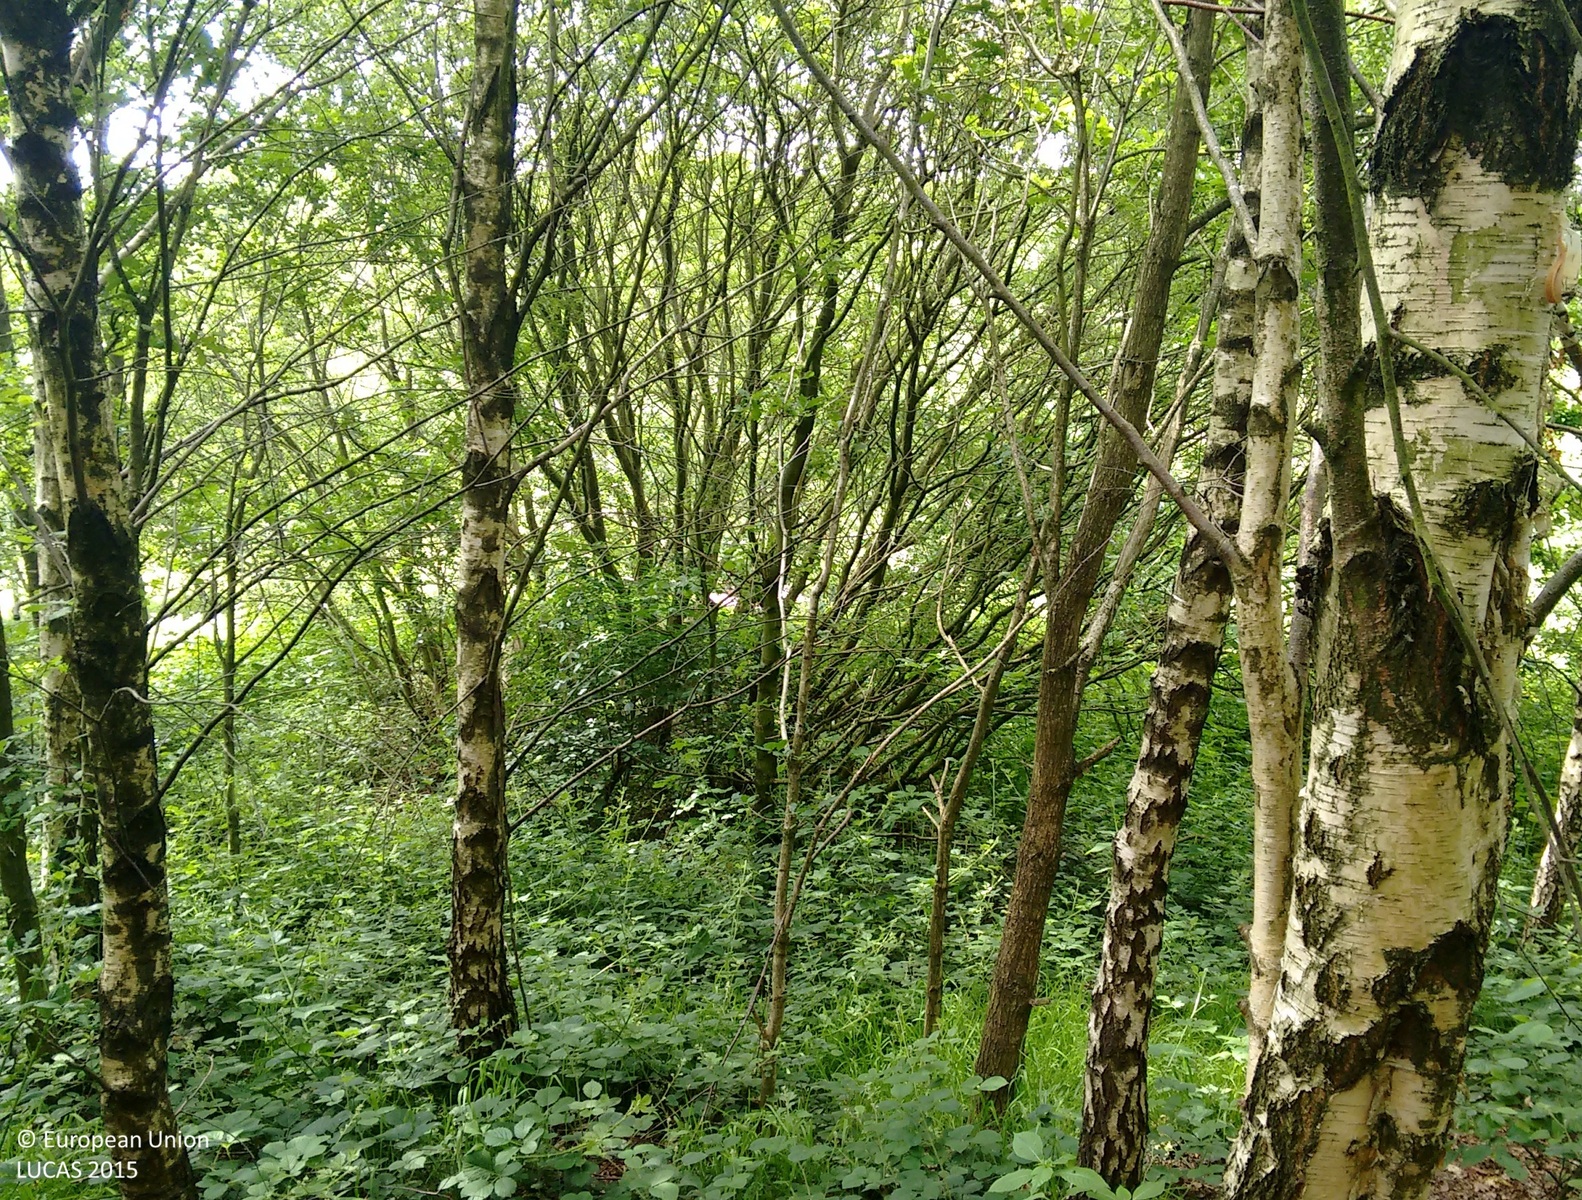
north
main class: Woodland
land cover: Broadleaved woodland
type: mesophytic deciduous forest
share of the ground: > 75 %
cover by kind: broadleaved forest trees 100 %
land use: Sport
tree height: > 5 m
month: June
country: GB
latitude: 53.4984
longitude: -2.1345
